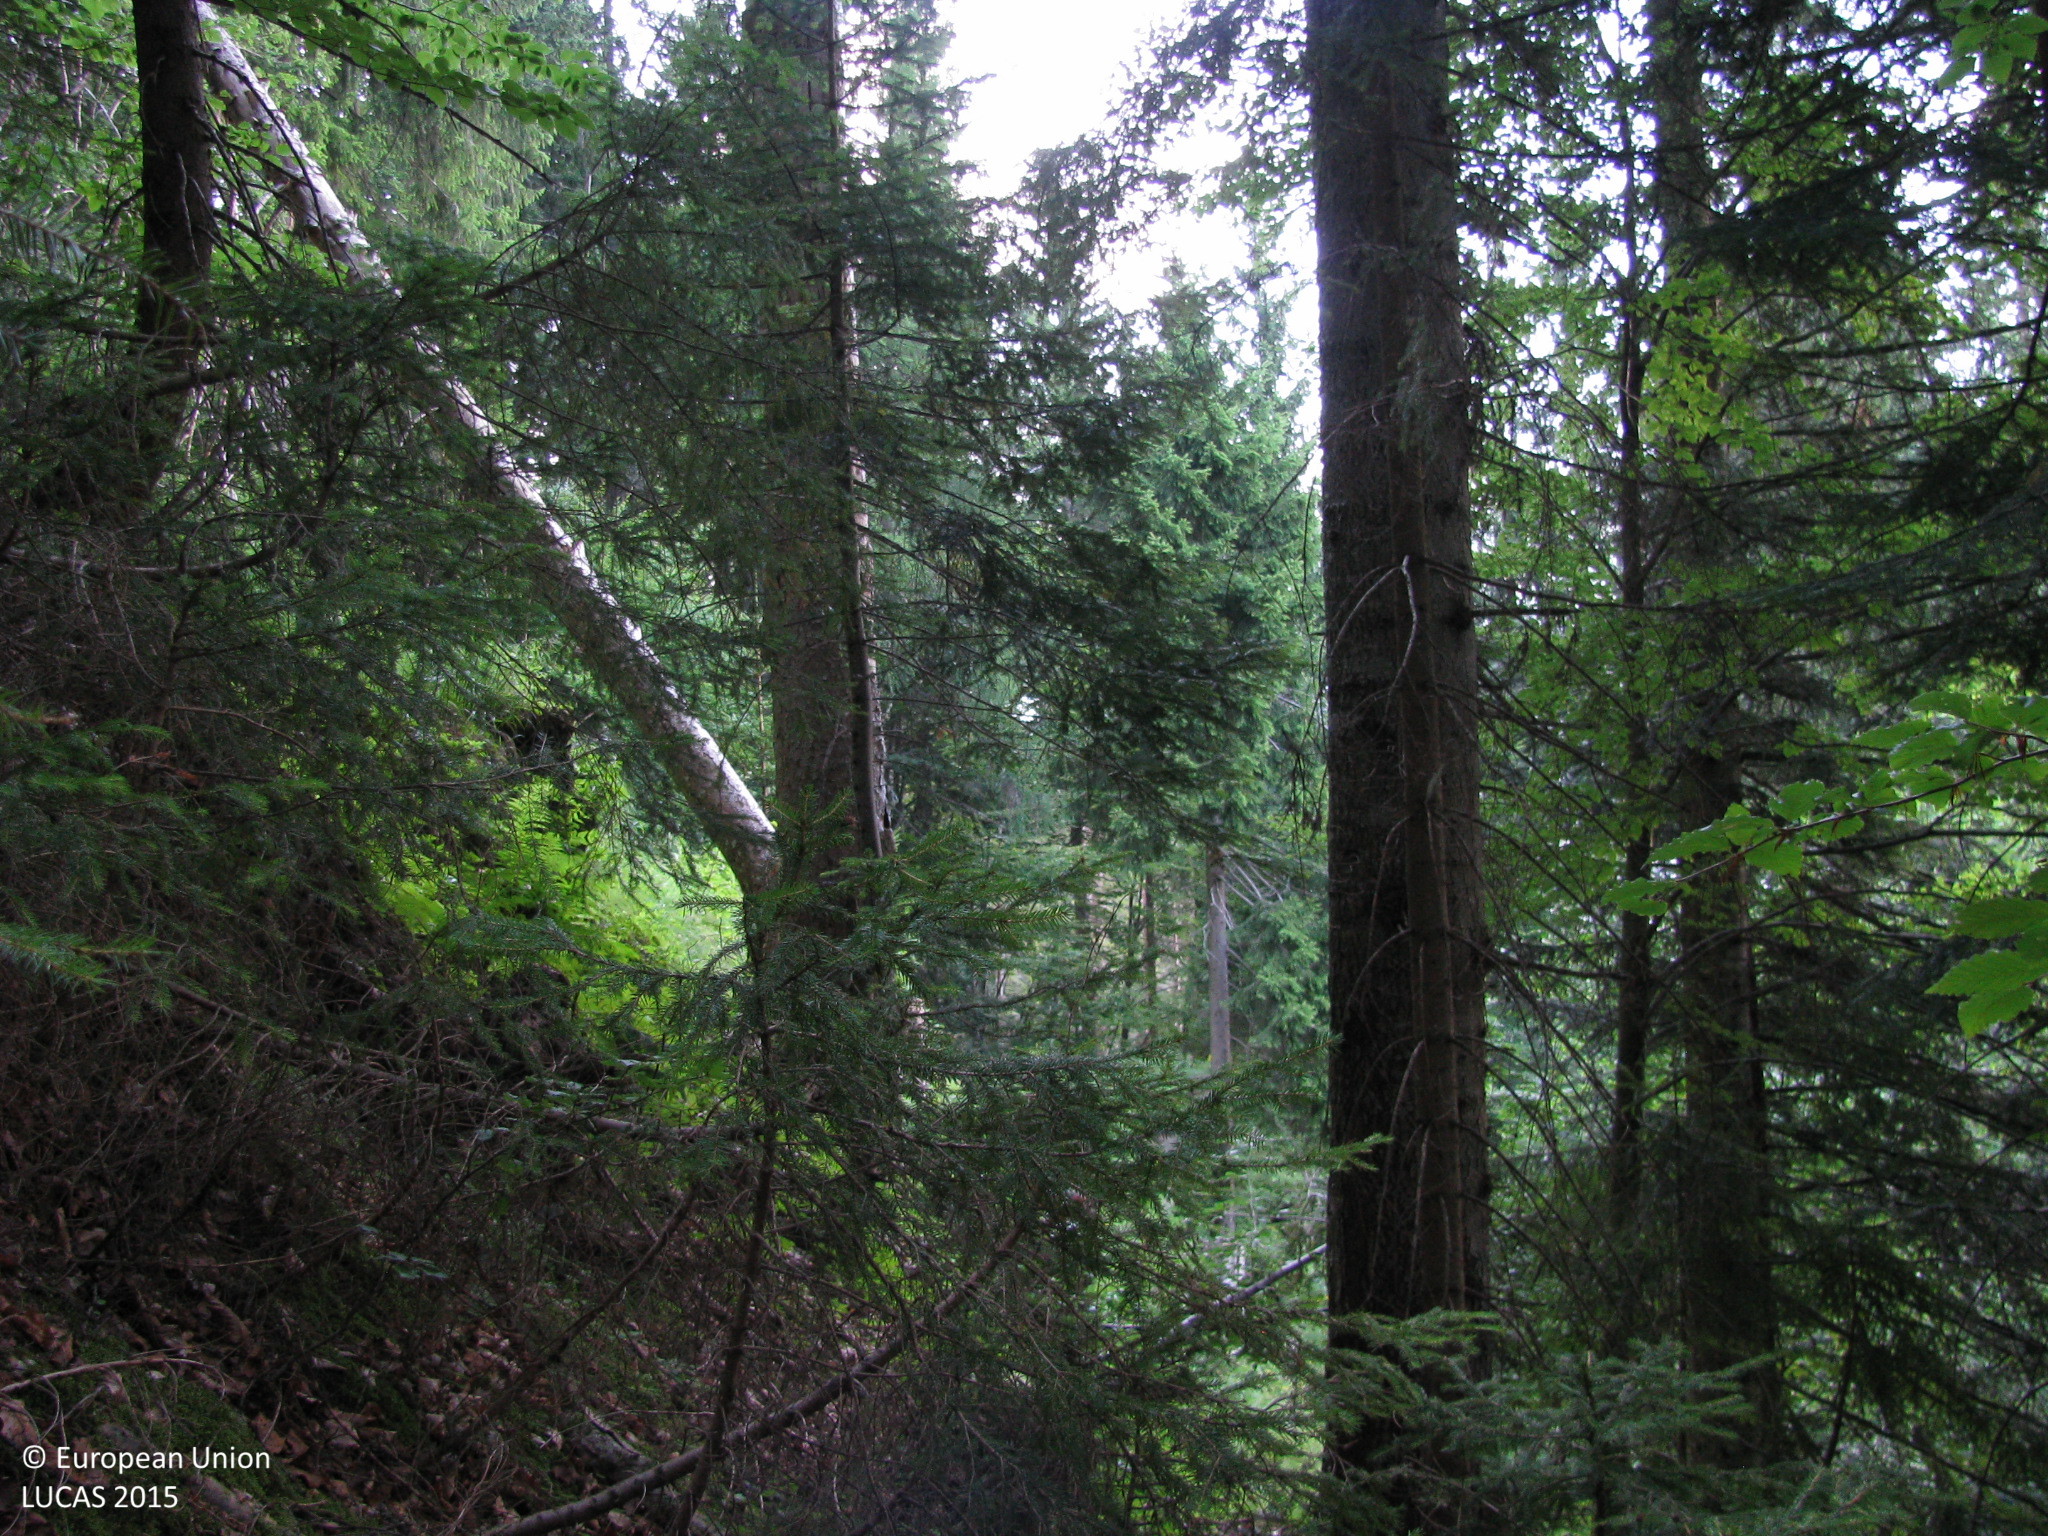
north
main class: Woodland
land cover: Other coniferous woodland
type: alpine coniferous forest
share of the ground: > 75 %
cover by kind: coniferous forest trees 75 %, broadleaved forest trees 15 %, herbaceous plants 10 %
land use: Forestry
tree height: > 5 m
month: July
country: AT
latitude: 46.6741
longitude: 12.8340
